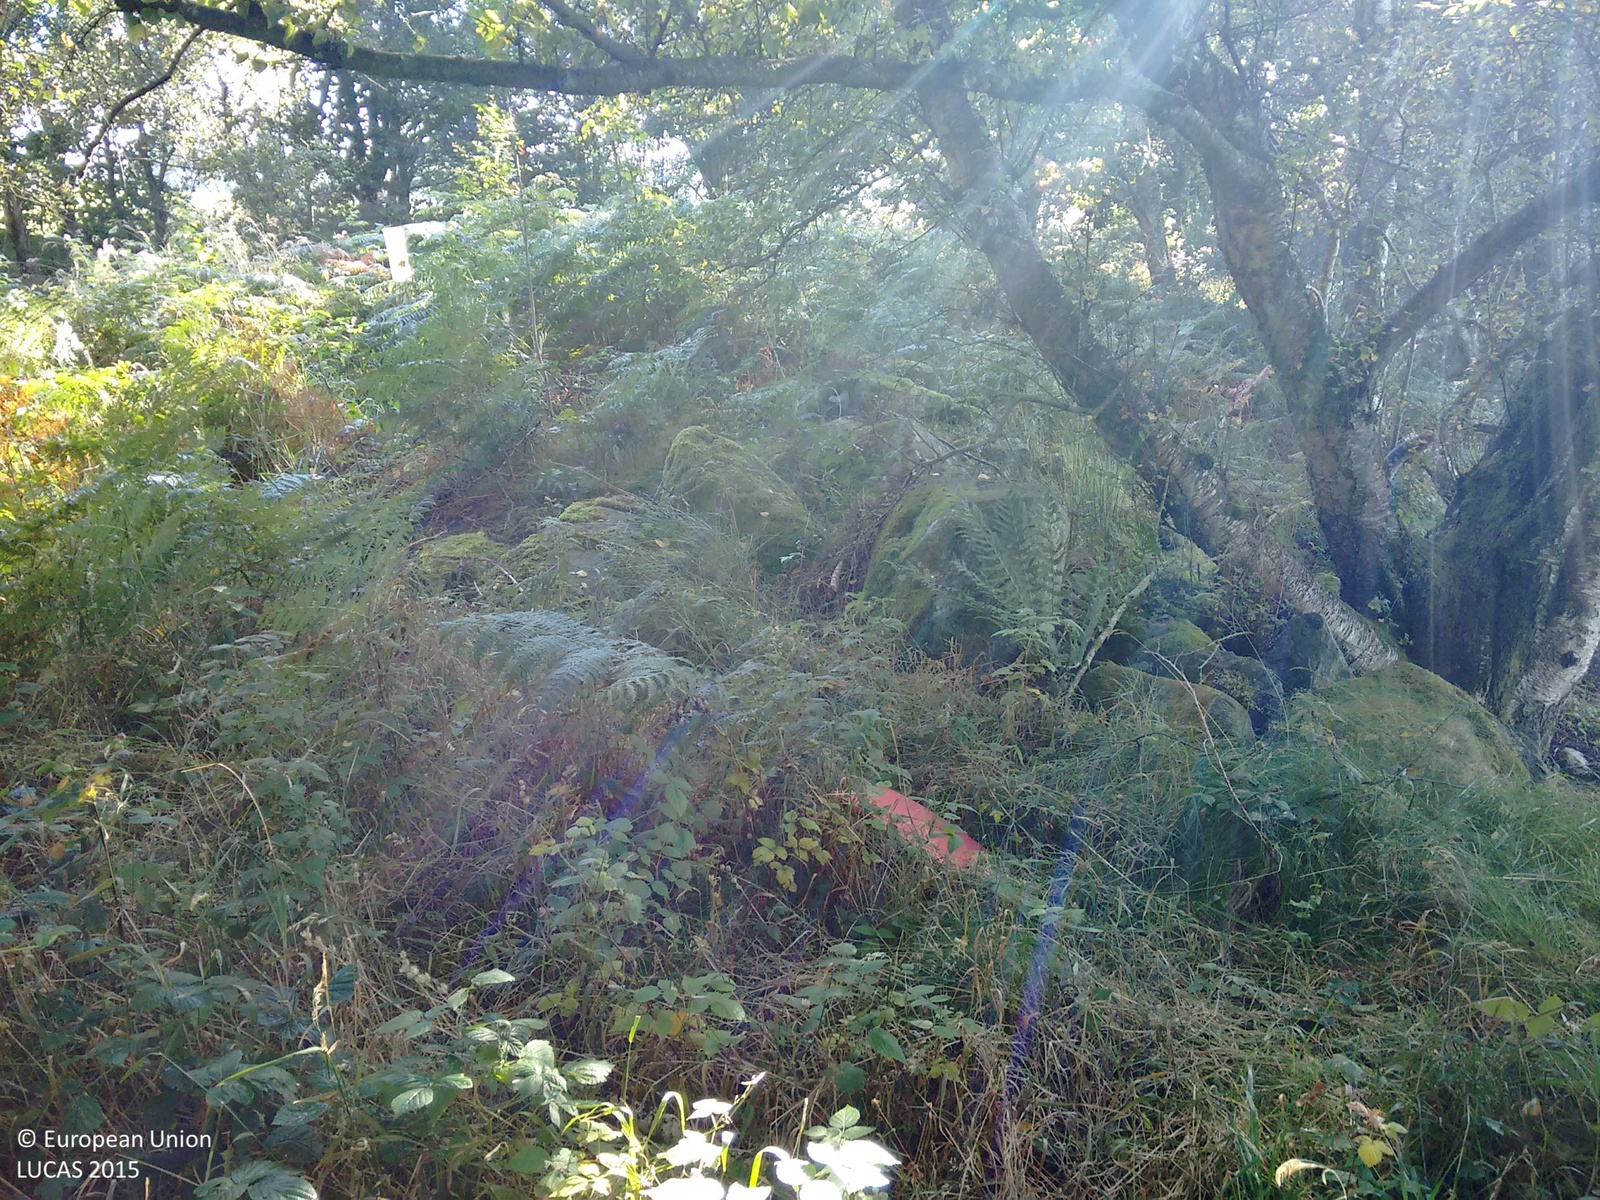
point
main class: Woodland
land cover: Broadleaved woodland
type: floodplain forest
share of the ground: > 75 %
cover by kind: broadleaved forest trees 70 %, herbaceous plants 30 %
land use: Amenities, museums, leisure
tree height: > 5 m
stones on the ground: < 10 %
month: September
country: GB
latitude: 56.5799
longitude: -3.5387
